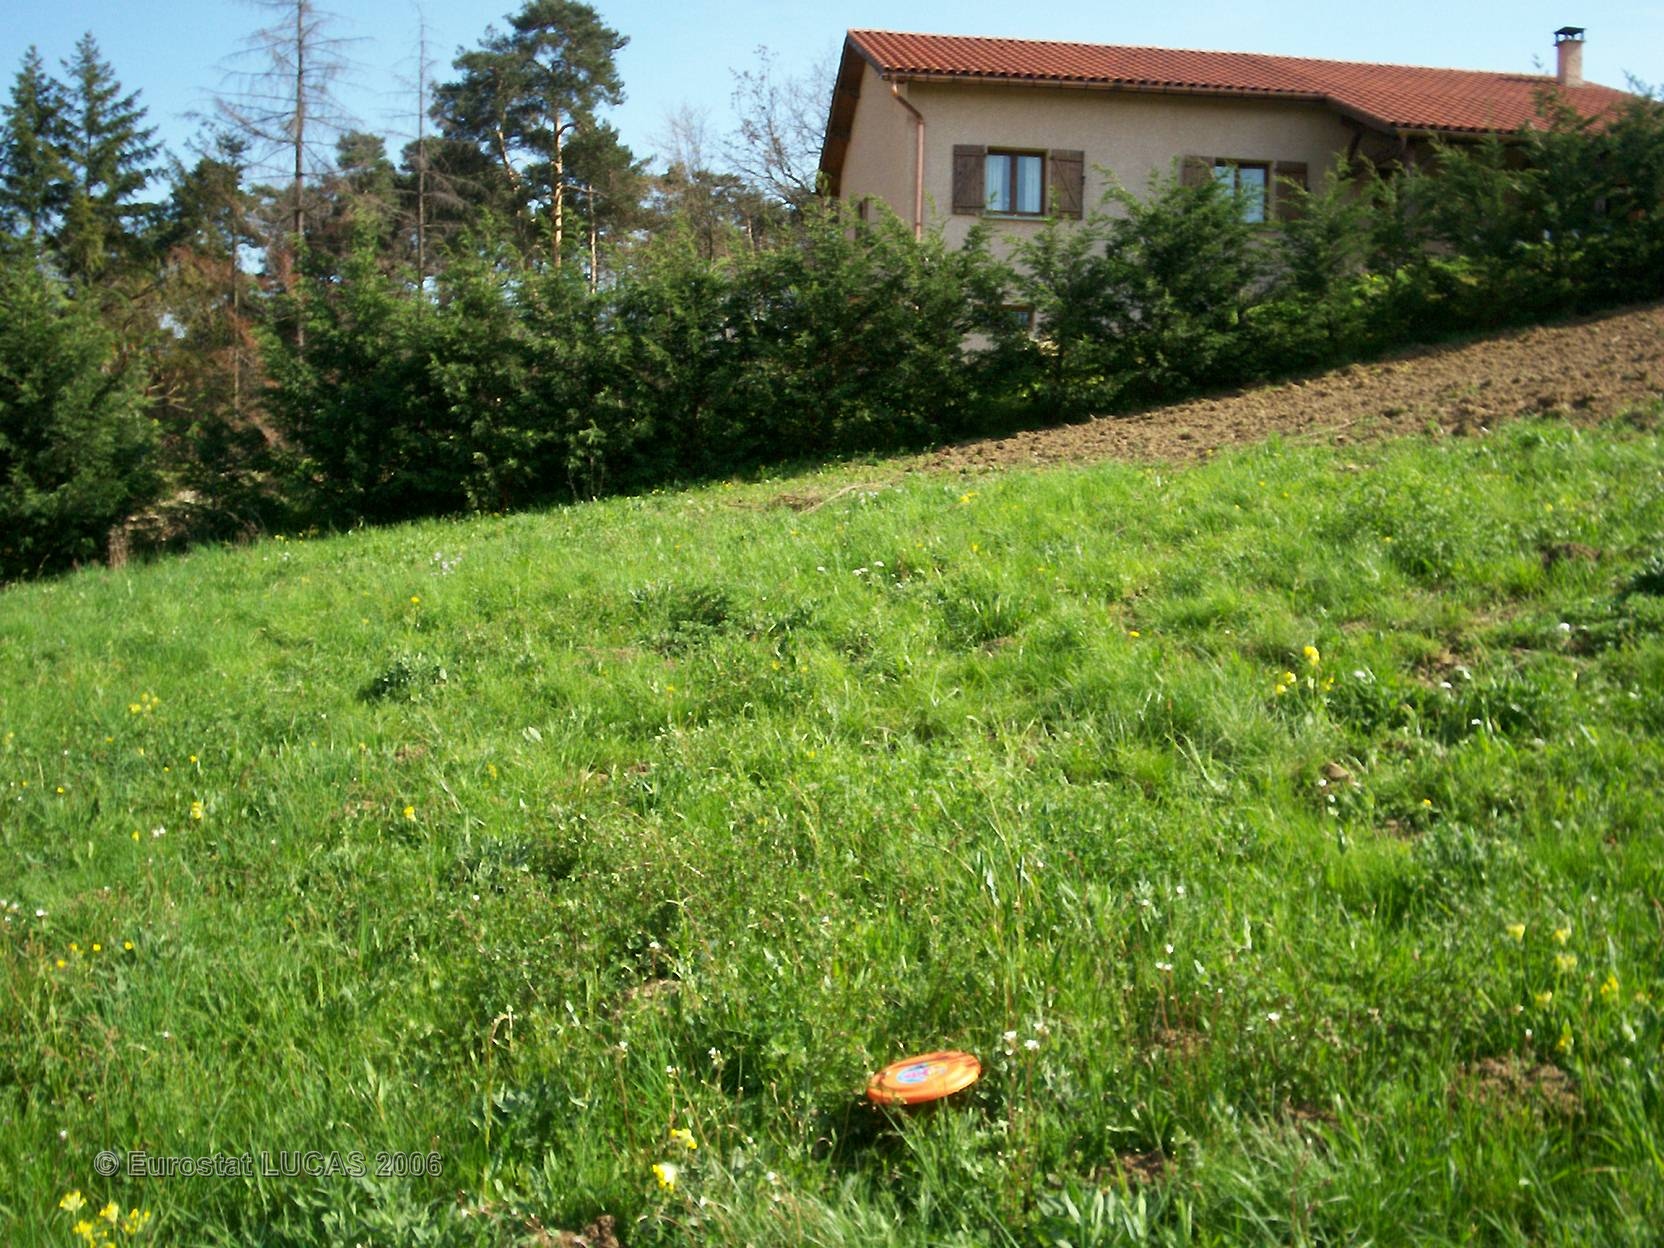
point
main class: Grassland
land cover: Grassland without tree/shrub cover
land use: Agriculture (excluding fallow land and kitchen gardens)
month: April
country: FR
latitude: 45.5384
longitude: 4.7919
